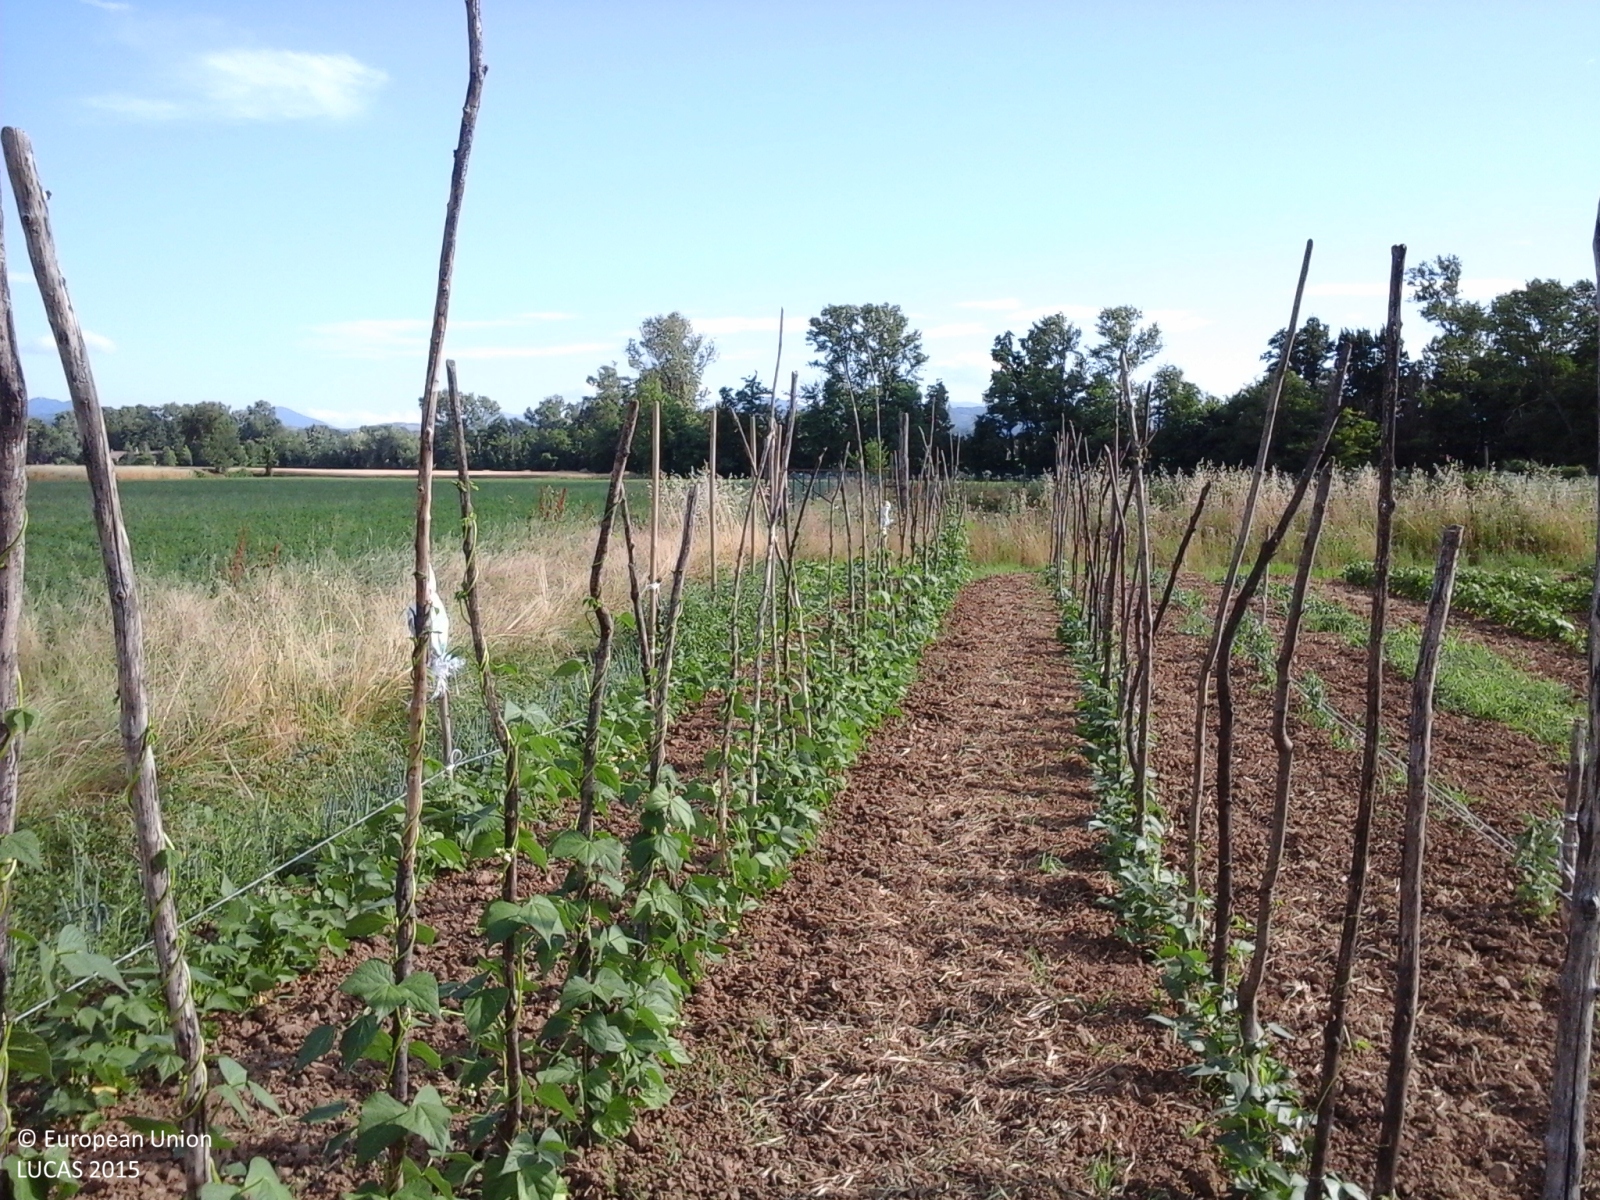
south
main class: Cropland
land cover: Other fresh vegetables
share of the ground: < 10 %
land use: Kitchen garden
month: June
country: IT
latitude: 44.9095
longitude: 9.8610
